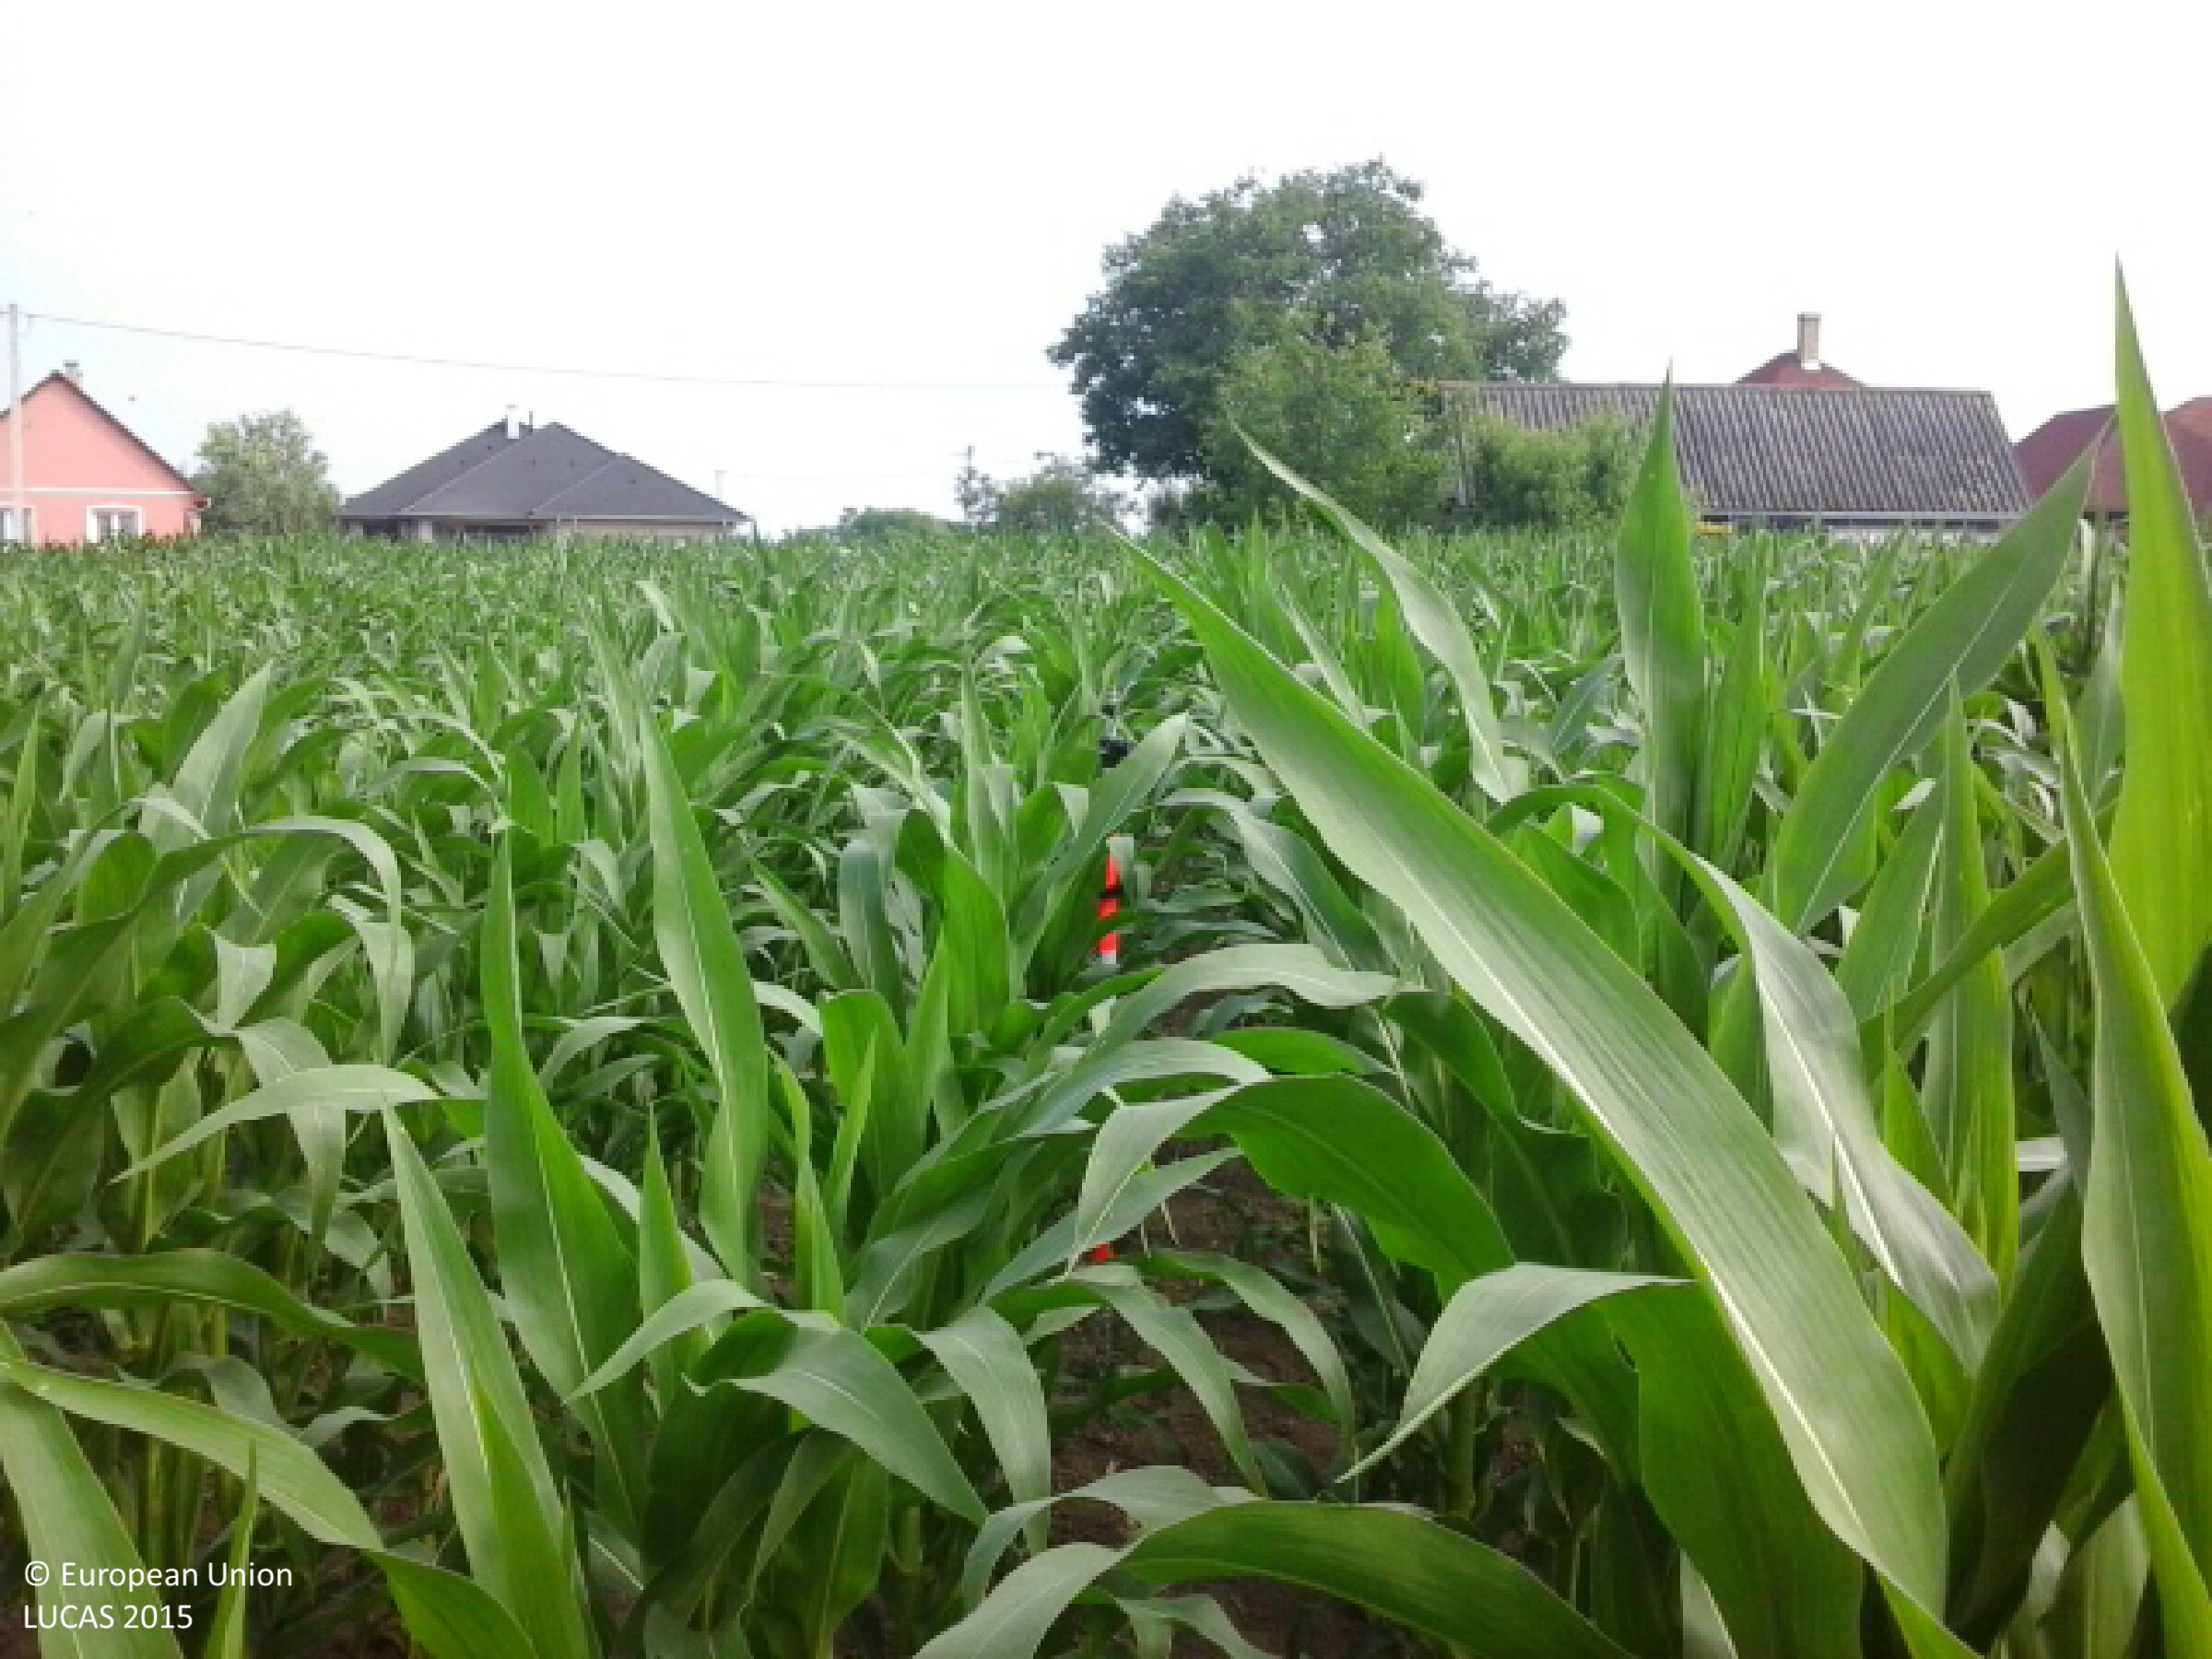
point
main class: Cropland
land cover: Maize
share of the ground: > 75 %
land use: Agriculture (excluding fallow land and kitchen gardens)
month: June
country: HU
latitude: 48.1089
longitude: 22.0196
